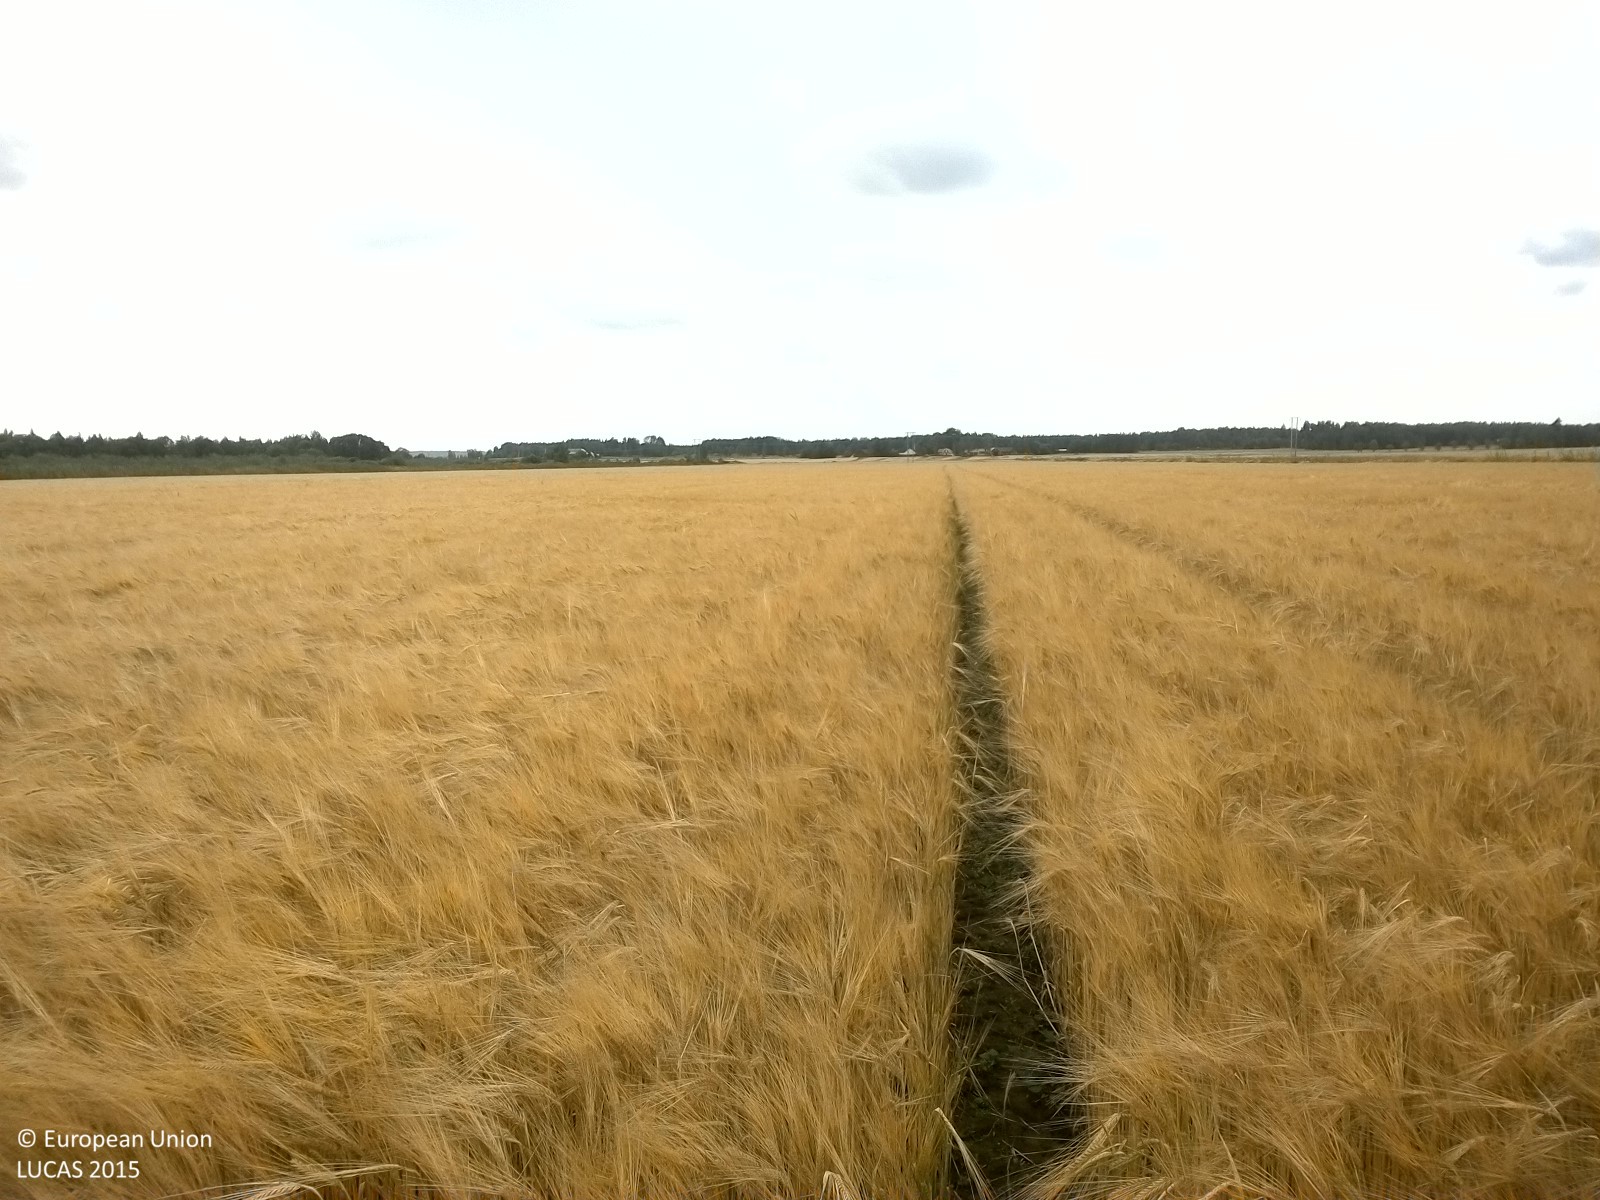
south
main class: Cropland
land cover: Barley
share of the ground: > 75 %
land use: Agriculture (excluding fallow land and kitchen gardens)
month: August
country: SE
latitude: 59.1141
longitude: 15.1094
